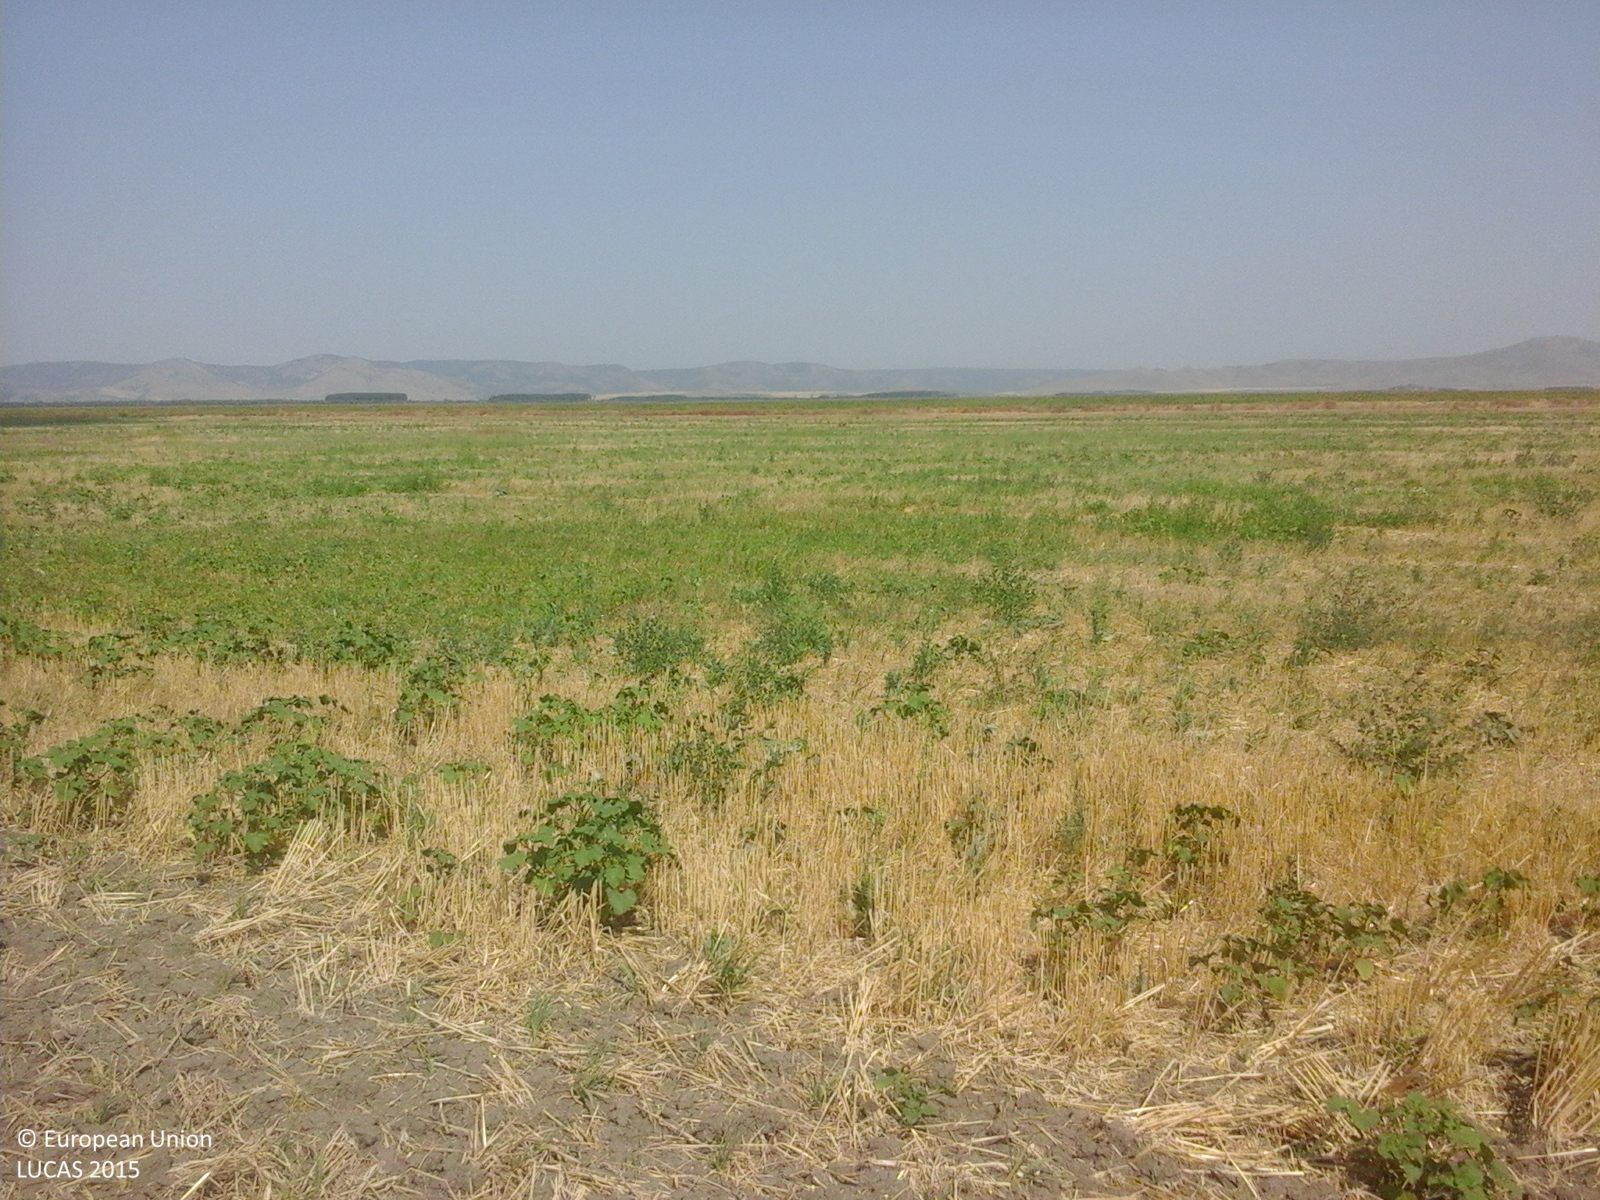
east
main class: Cropland
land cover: Common wheat
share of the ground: 50 - 75 %
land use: Agriculture (excluding fallow land and kitchen gardens)
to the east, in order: Common wheat
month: August
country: RO
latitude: 45.1386
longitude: 28.1116
